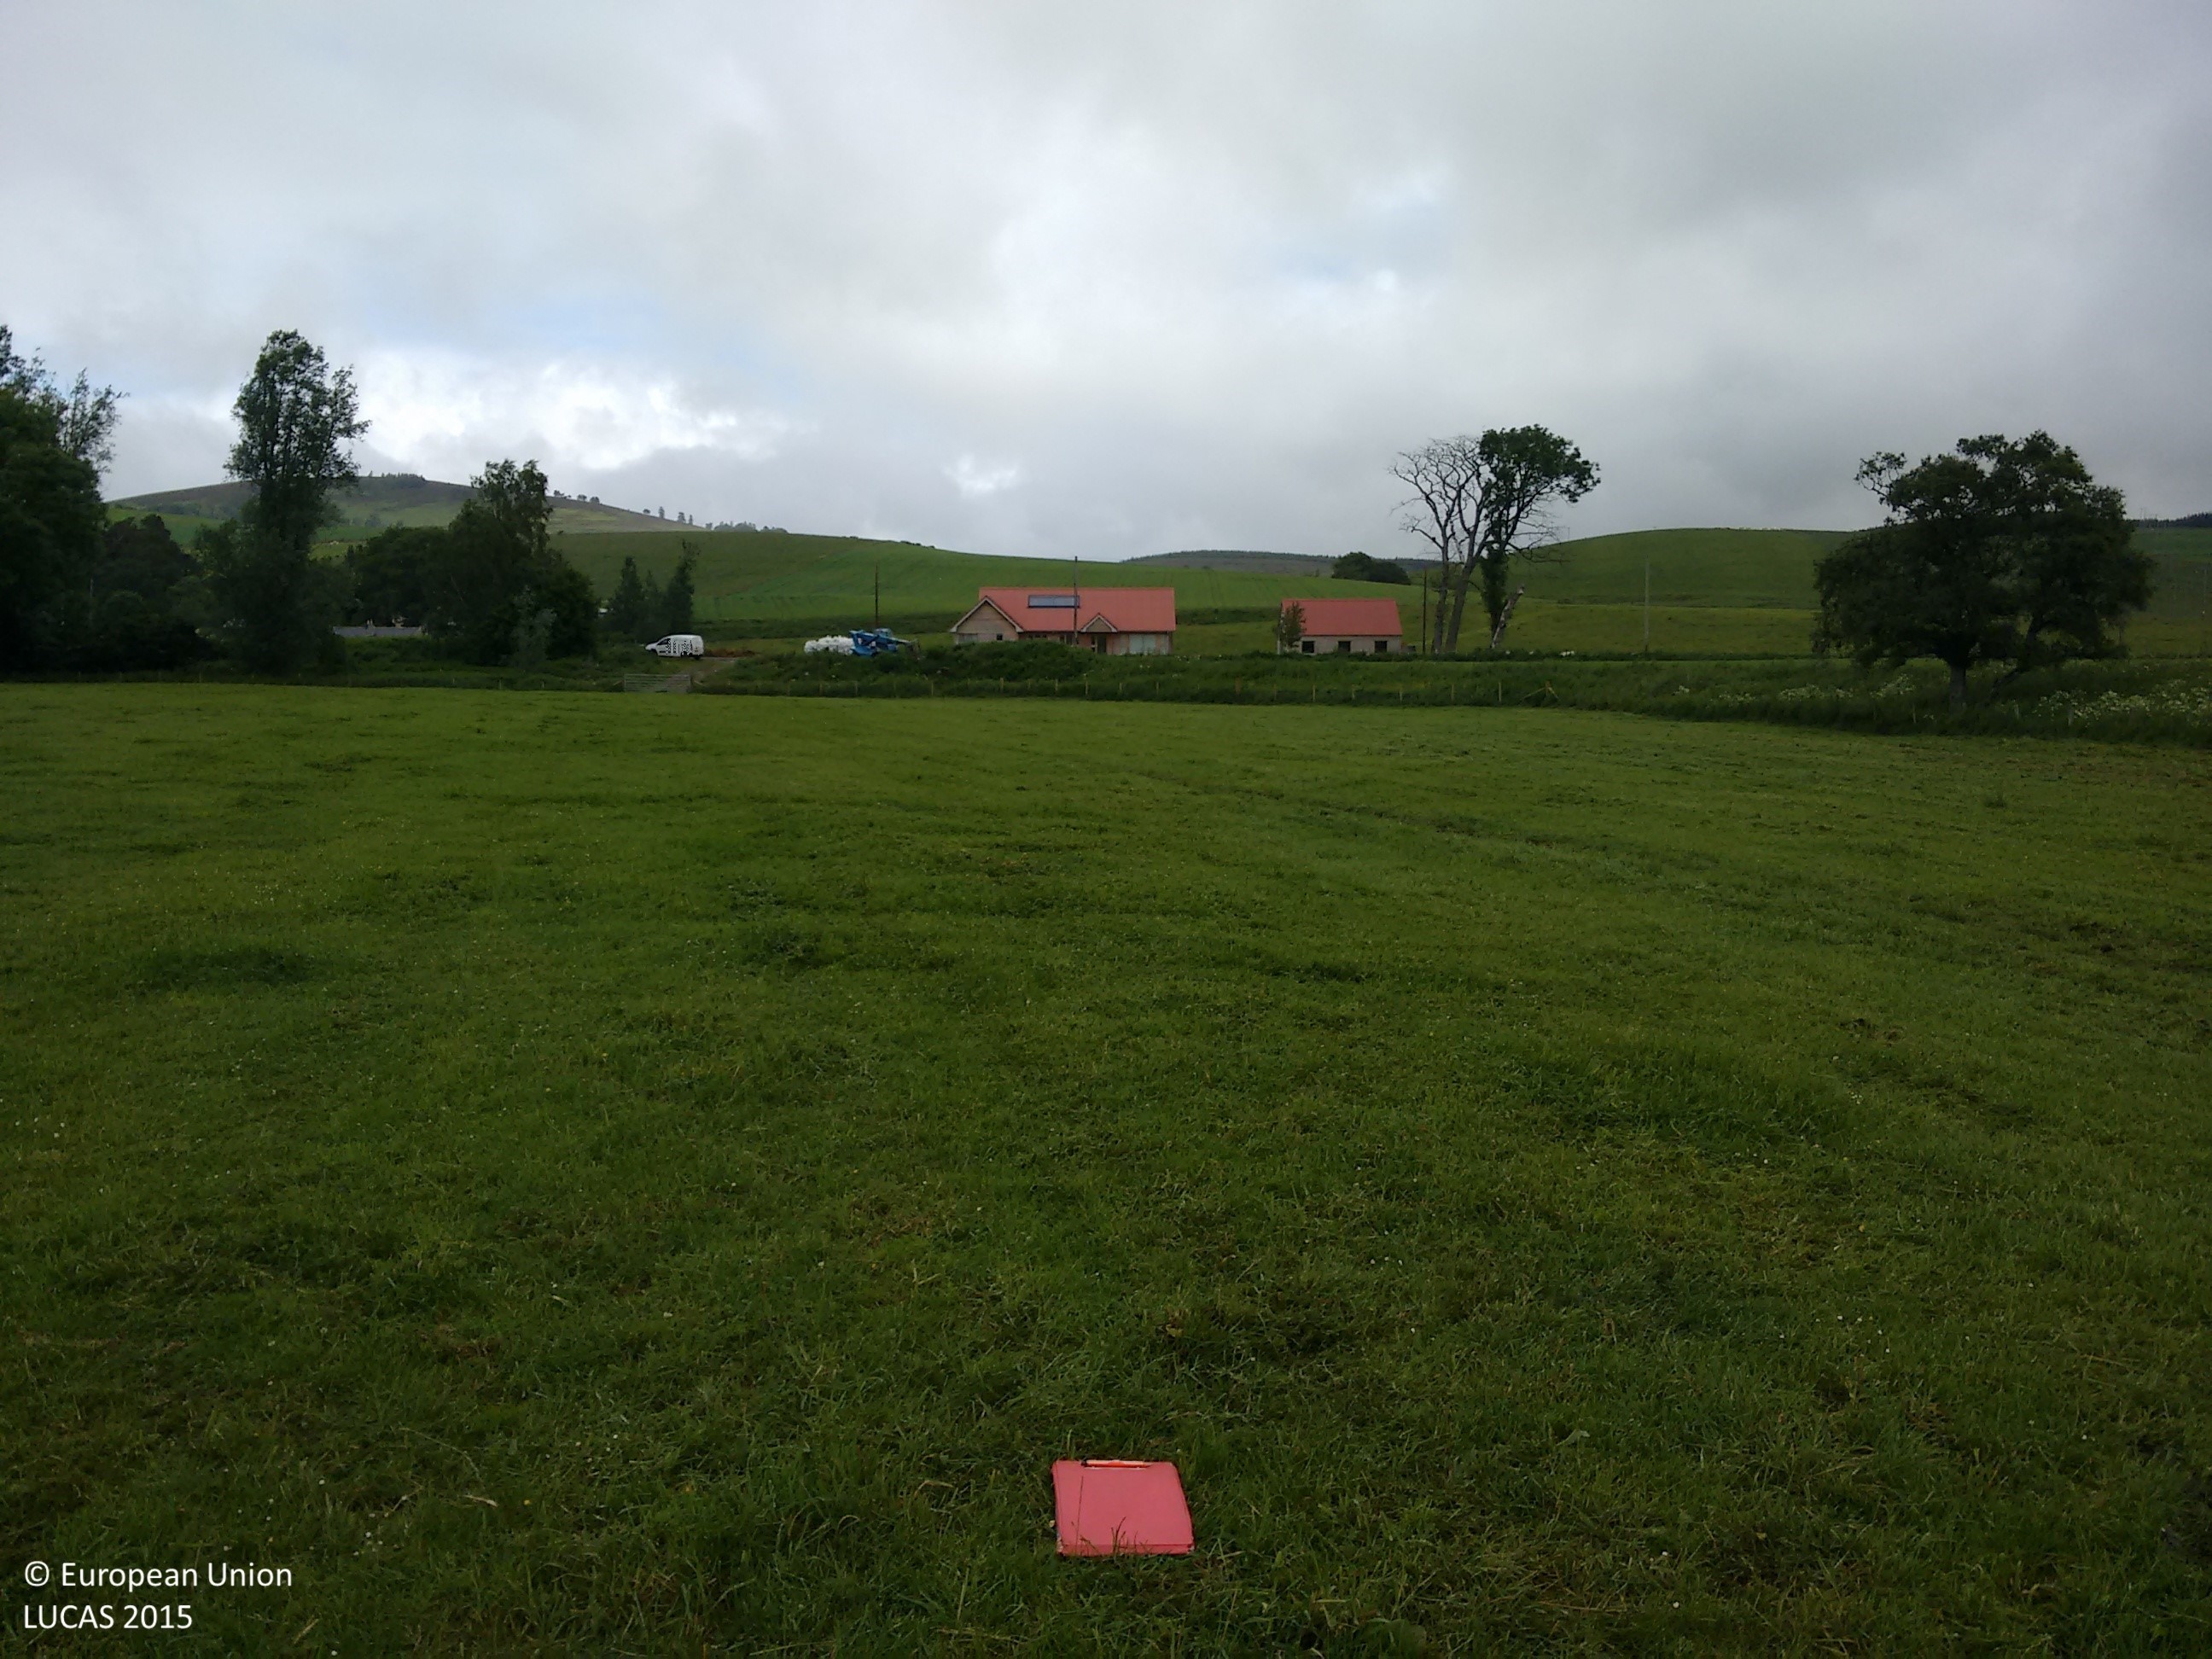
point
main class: Grassland
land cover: Grassland without tree/shrub cover
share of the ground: > 75 %
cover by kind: herbaceous plants 100 %
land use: Agriculture (excluding fallow land and kitchen gardens)
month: July
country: GB
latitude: 57.2087
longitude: -2.9249
